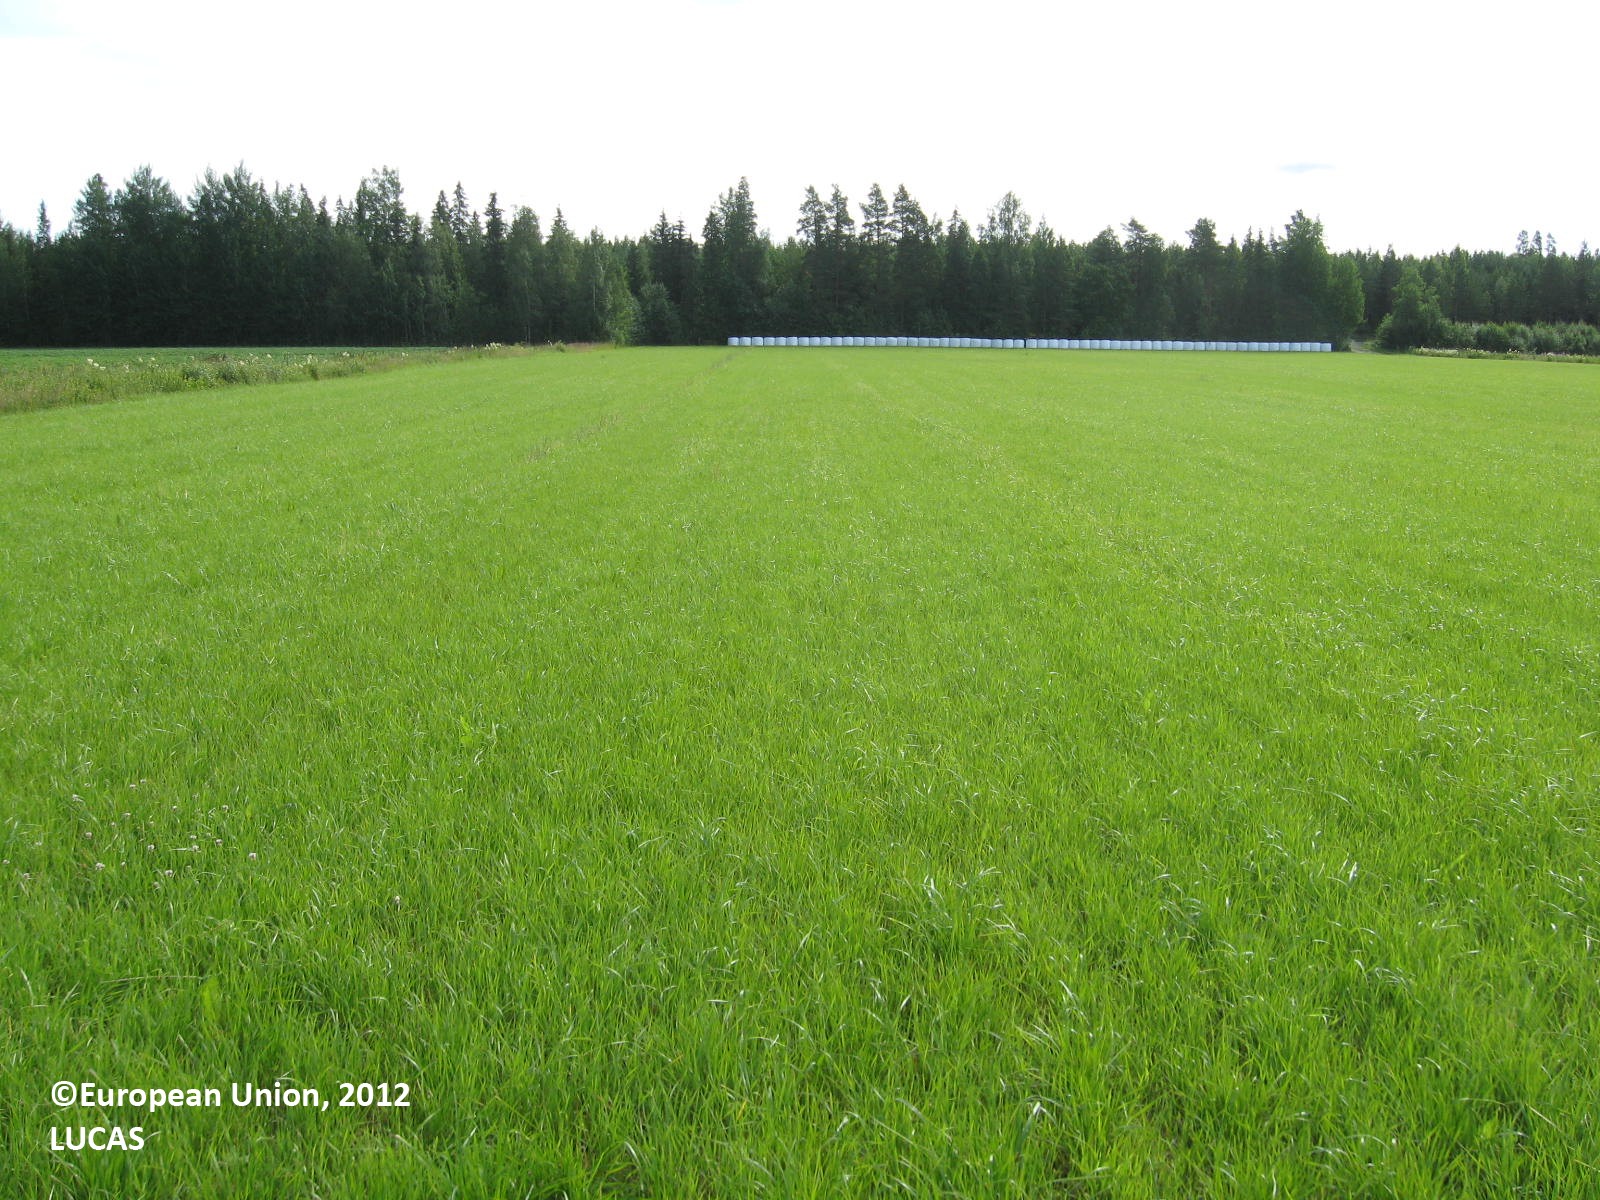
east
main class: Cropland
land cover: Temporary grasslands
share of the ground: > 75 %
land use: Agriculture (excluding fallow land and kitchen gardens)
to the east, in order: Temporary grasslands; Grass margins; Ditches and canals; Other mixed woodland; Grass margins; Paved roads, cycling and walking lanes; Grass margins; Ditches and canals; Shruby margins; Pine dominated coniferous woodland
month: July
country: FI
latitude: 62.2790
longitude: 21.5108
